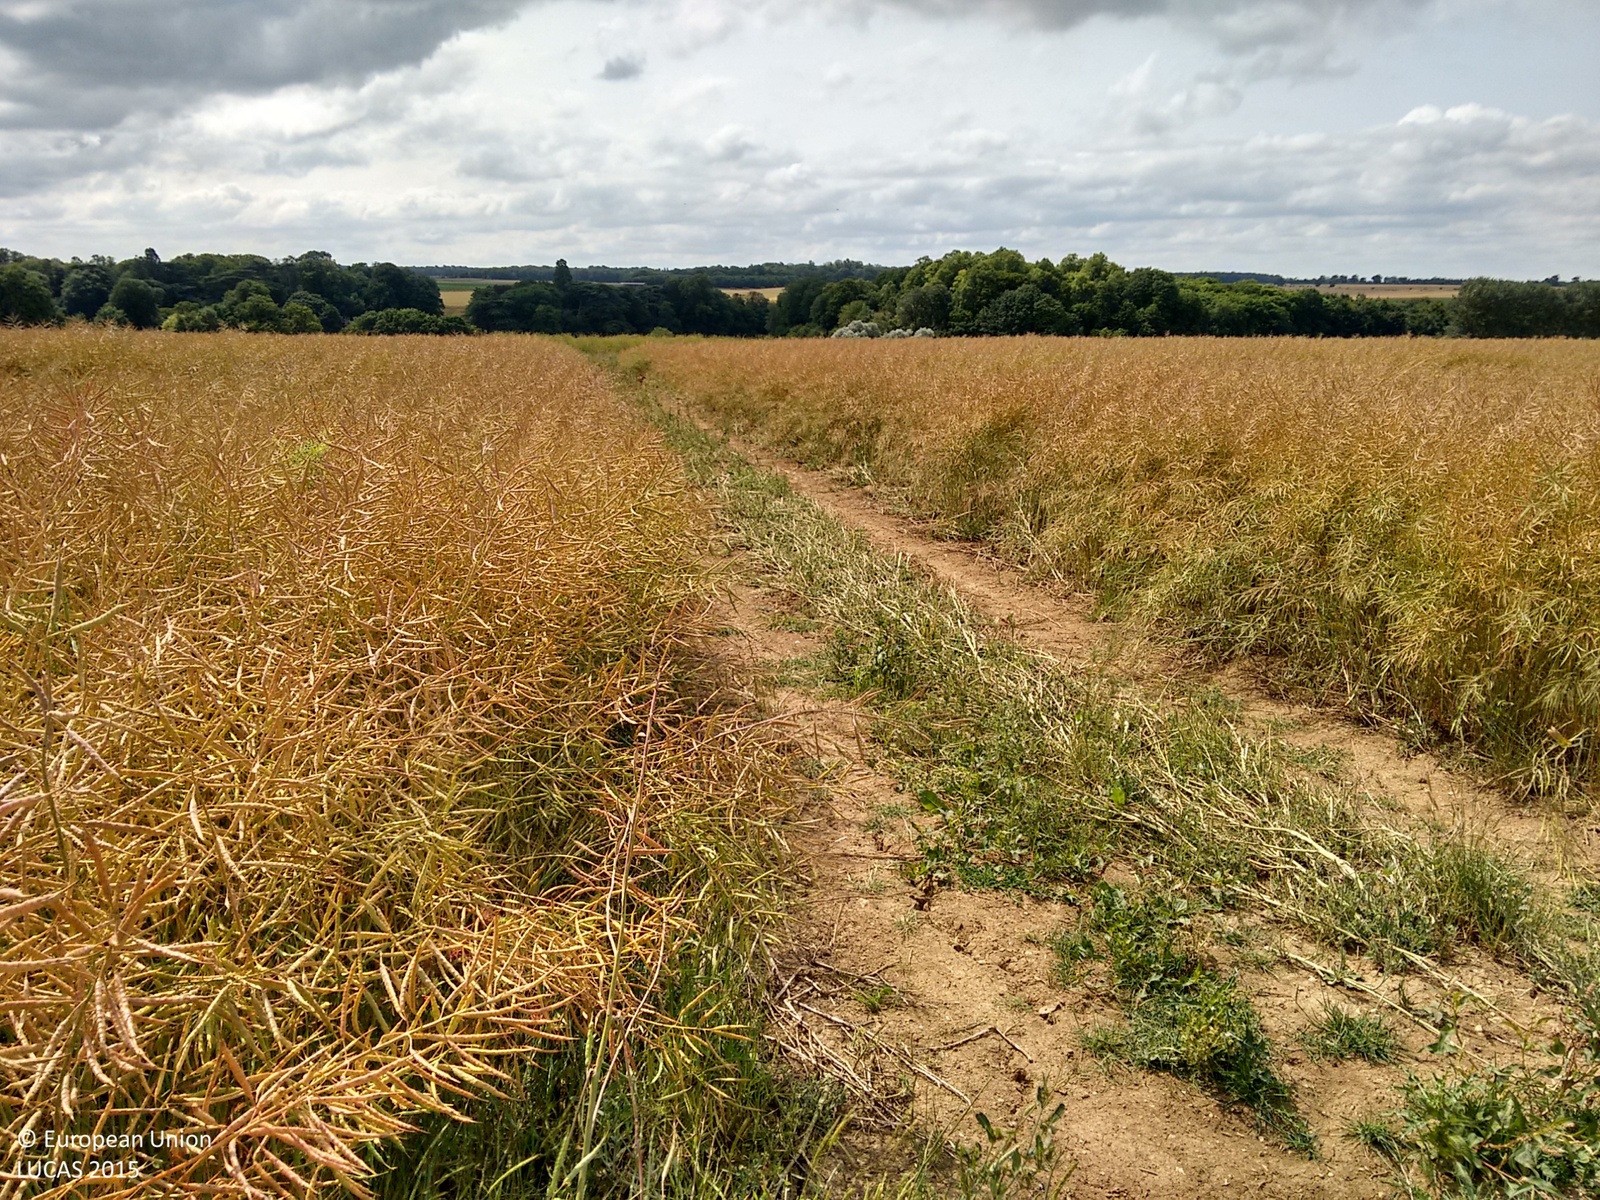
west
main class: Cropland
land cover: Rape and turnip rape
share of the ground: > 75 %
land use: Agriculture (excluding fallow land and kitchen gardens)
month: July
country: GB
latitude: 52.7004
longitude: -0.5902
